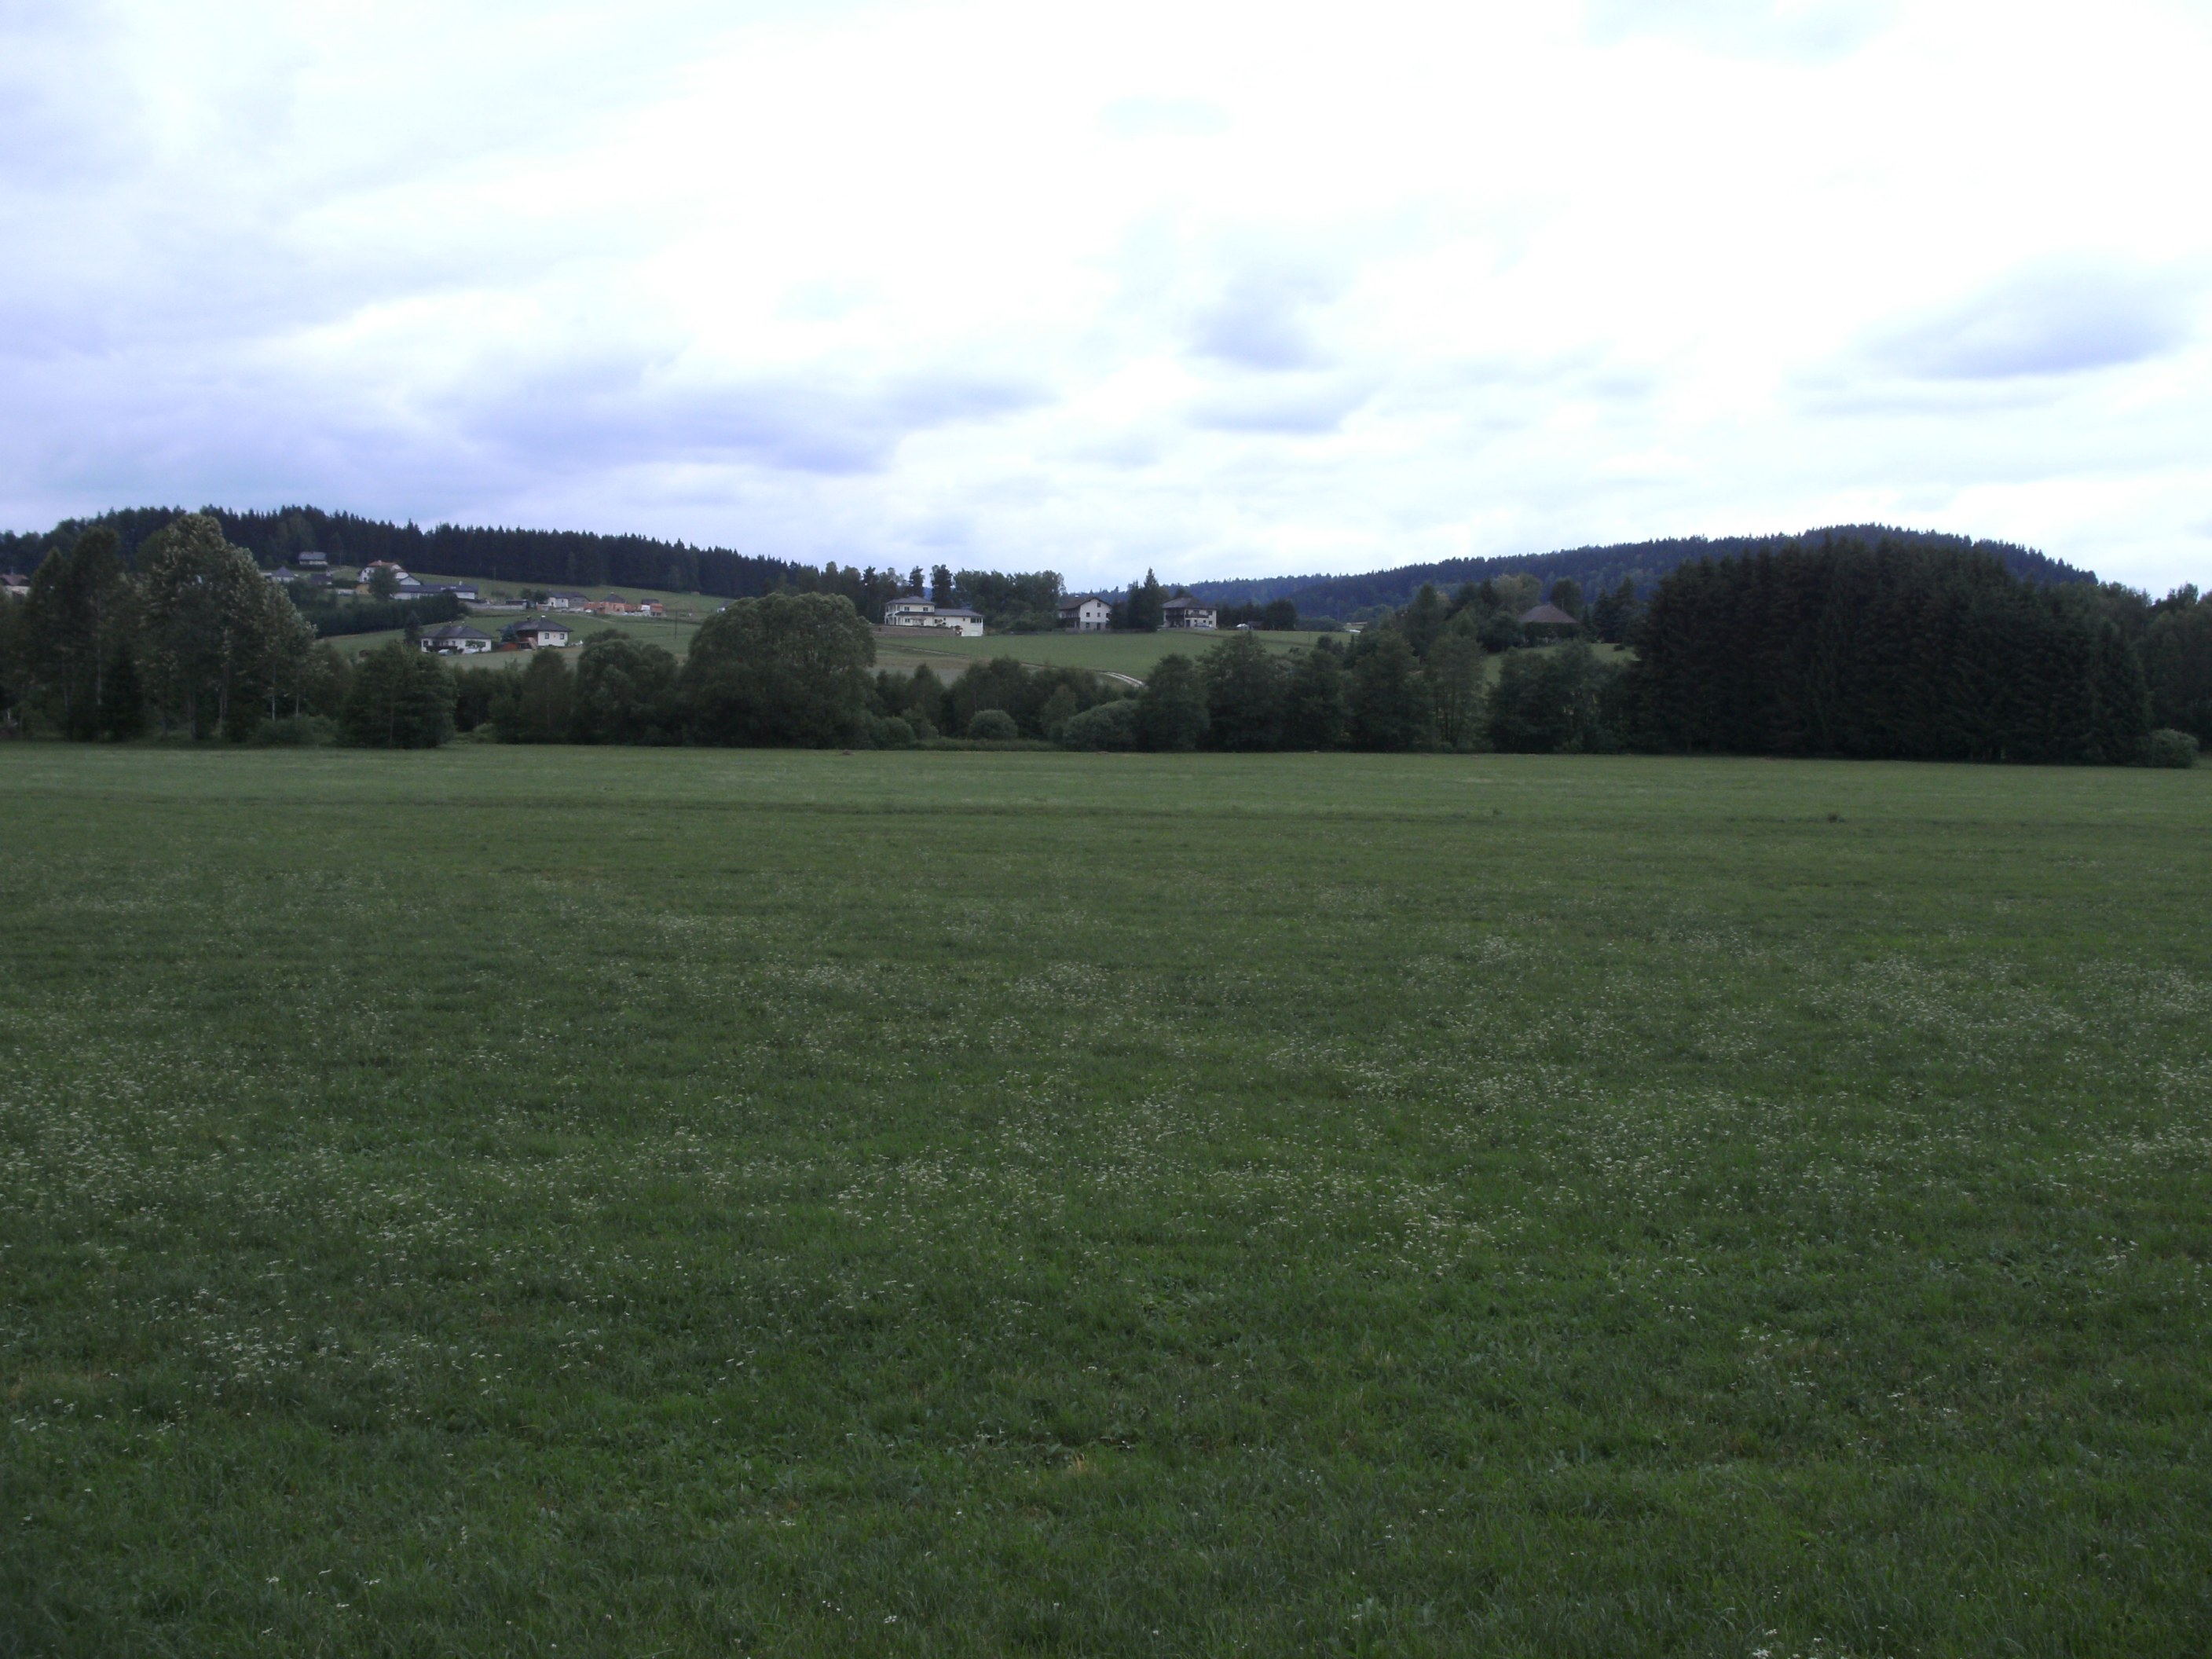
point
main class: Grassland
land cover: Grassland without tree/shrub cover
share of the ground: > 75 %
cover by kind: herbaceous plants 100 %
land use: Agriculture (excluding fallow land and kitchen gardens)
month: June
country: AT
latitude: 48.5585
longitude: 14.1870
